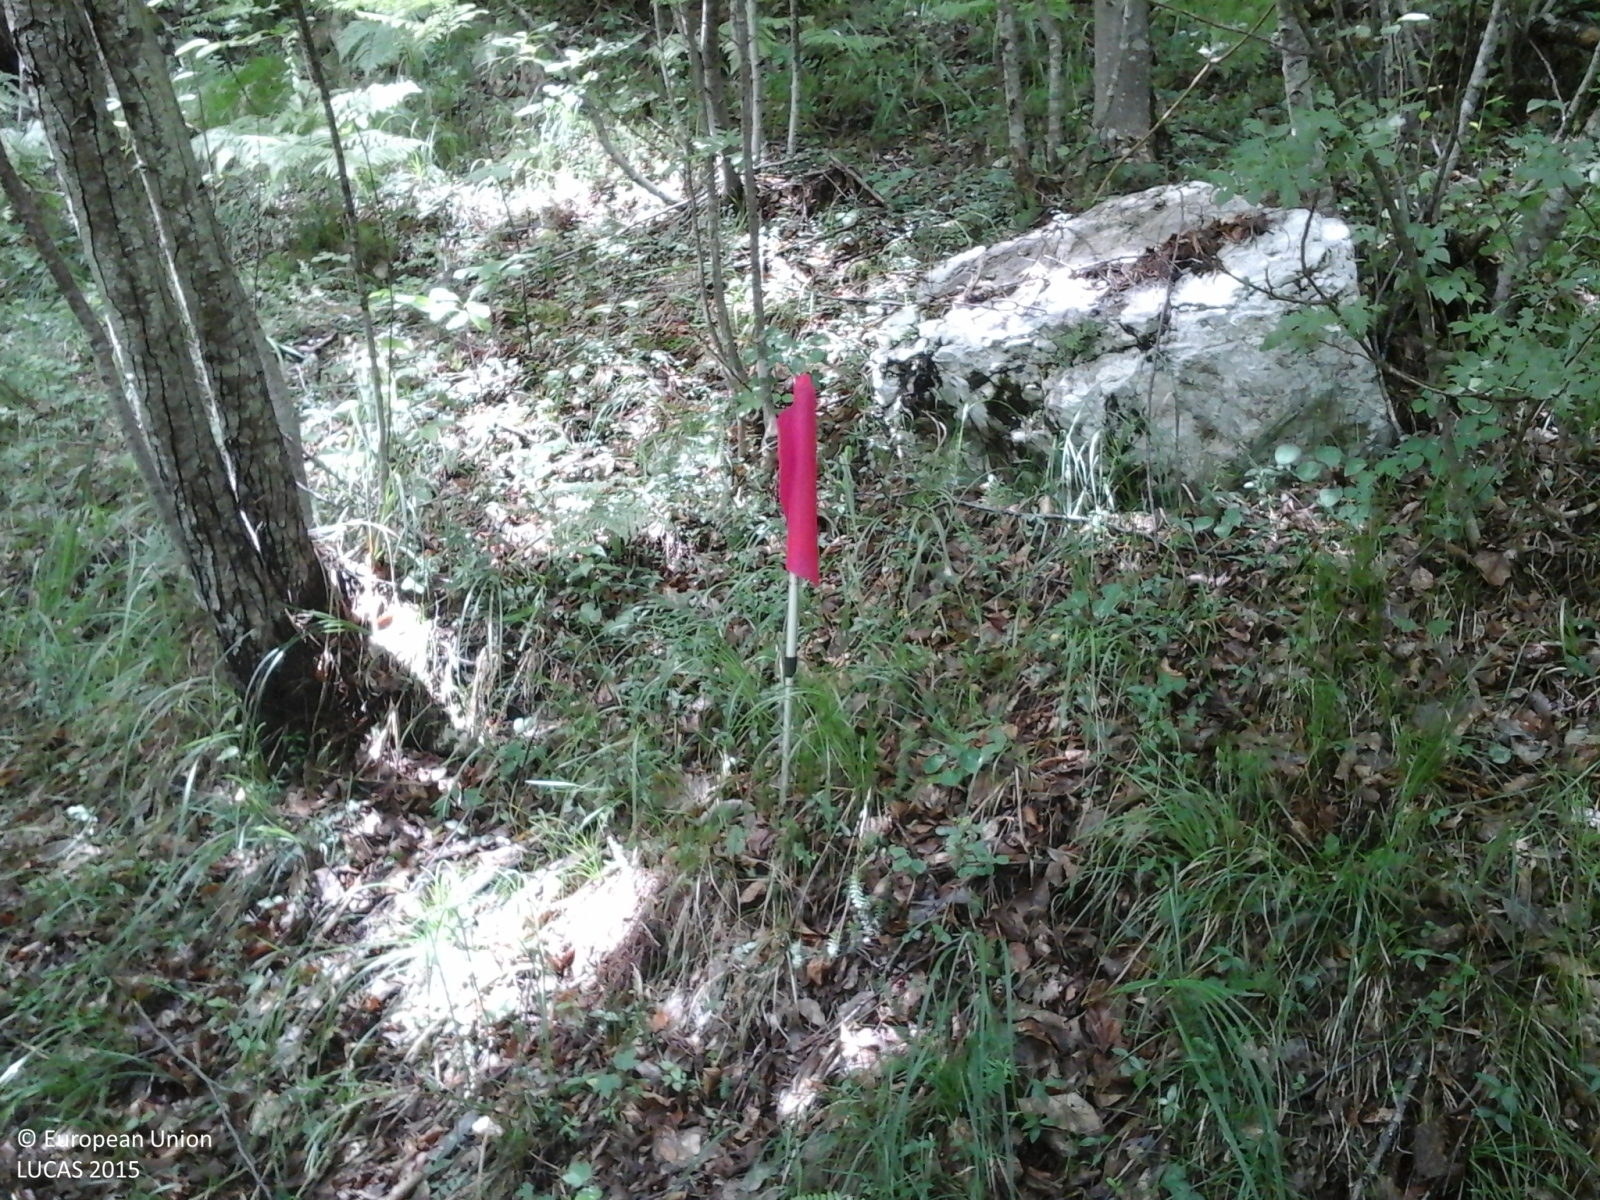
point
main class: Woodland
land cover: Broadleaved woodland
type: thermophilous deciduous forest
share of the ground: > 75 %
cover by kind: broadleaved forest trees 95 %, coniferous forest trees 5 %
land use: Forestry
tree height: > 5 m
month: June
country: IT
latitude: 46.0151
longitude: 11.5864
